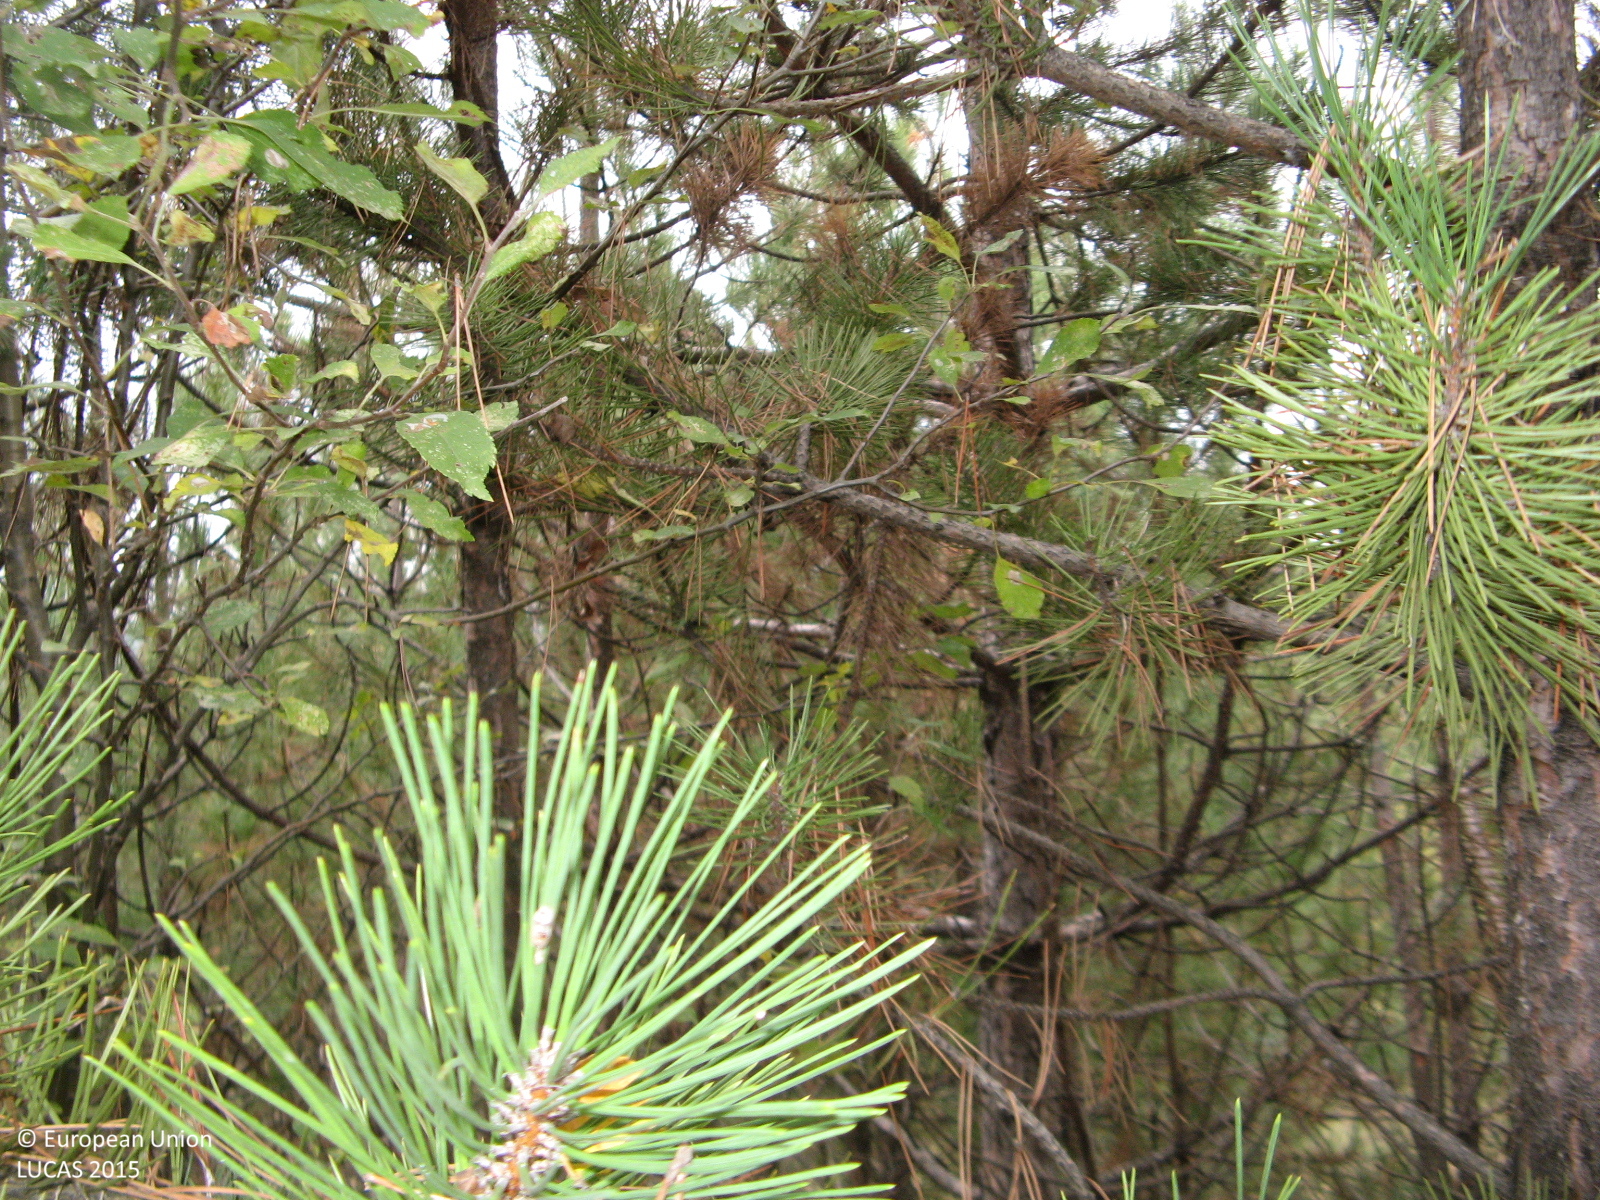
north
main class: Woodland
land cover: Pine dominated mixed woodland
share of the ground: > 75 %
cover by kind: coniferous forest trees 75 %, broadleaved forest trees 25 %
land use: Forestry
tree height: < 5 m
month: November
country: BG
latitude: 41.4058
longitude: 25.3286
